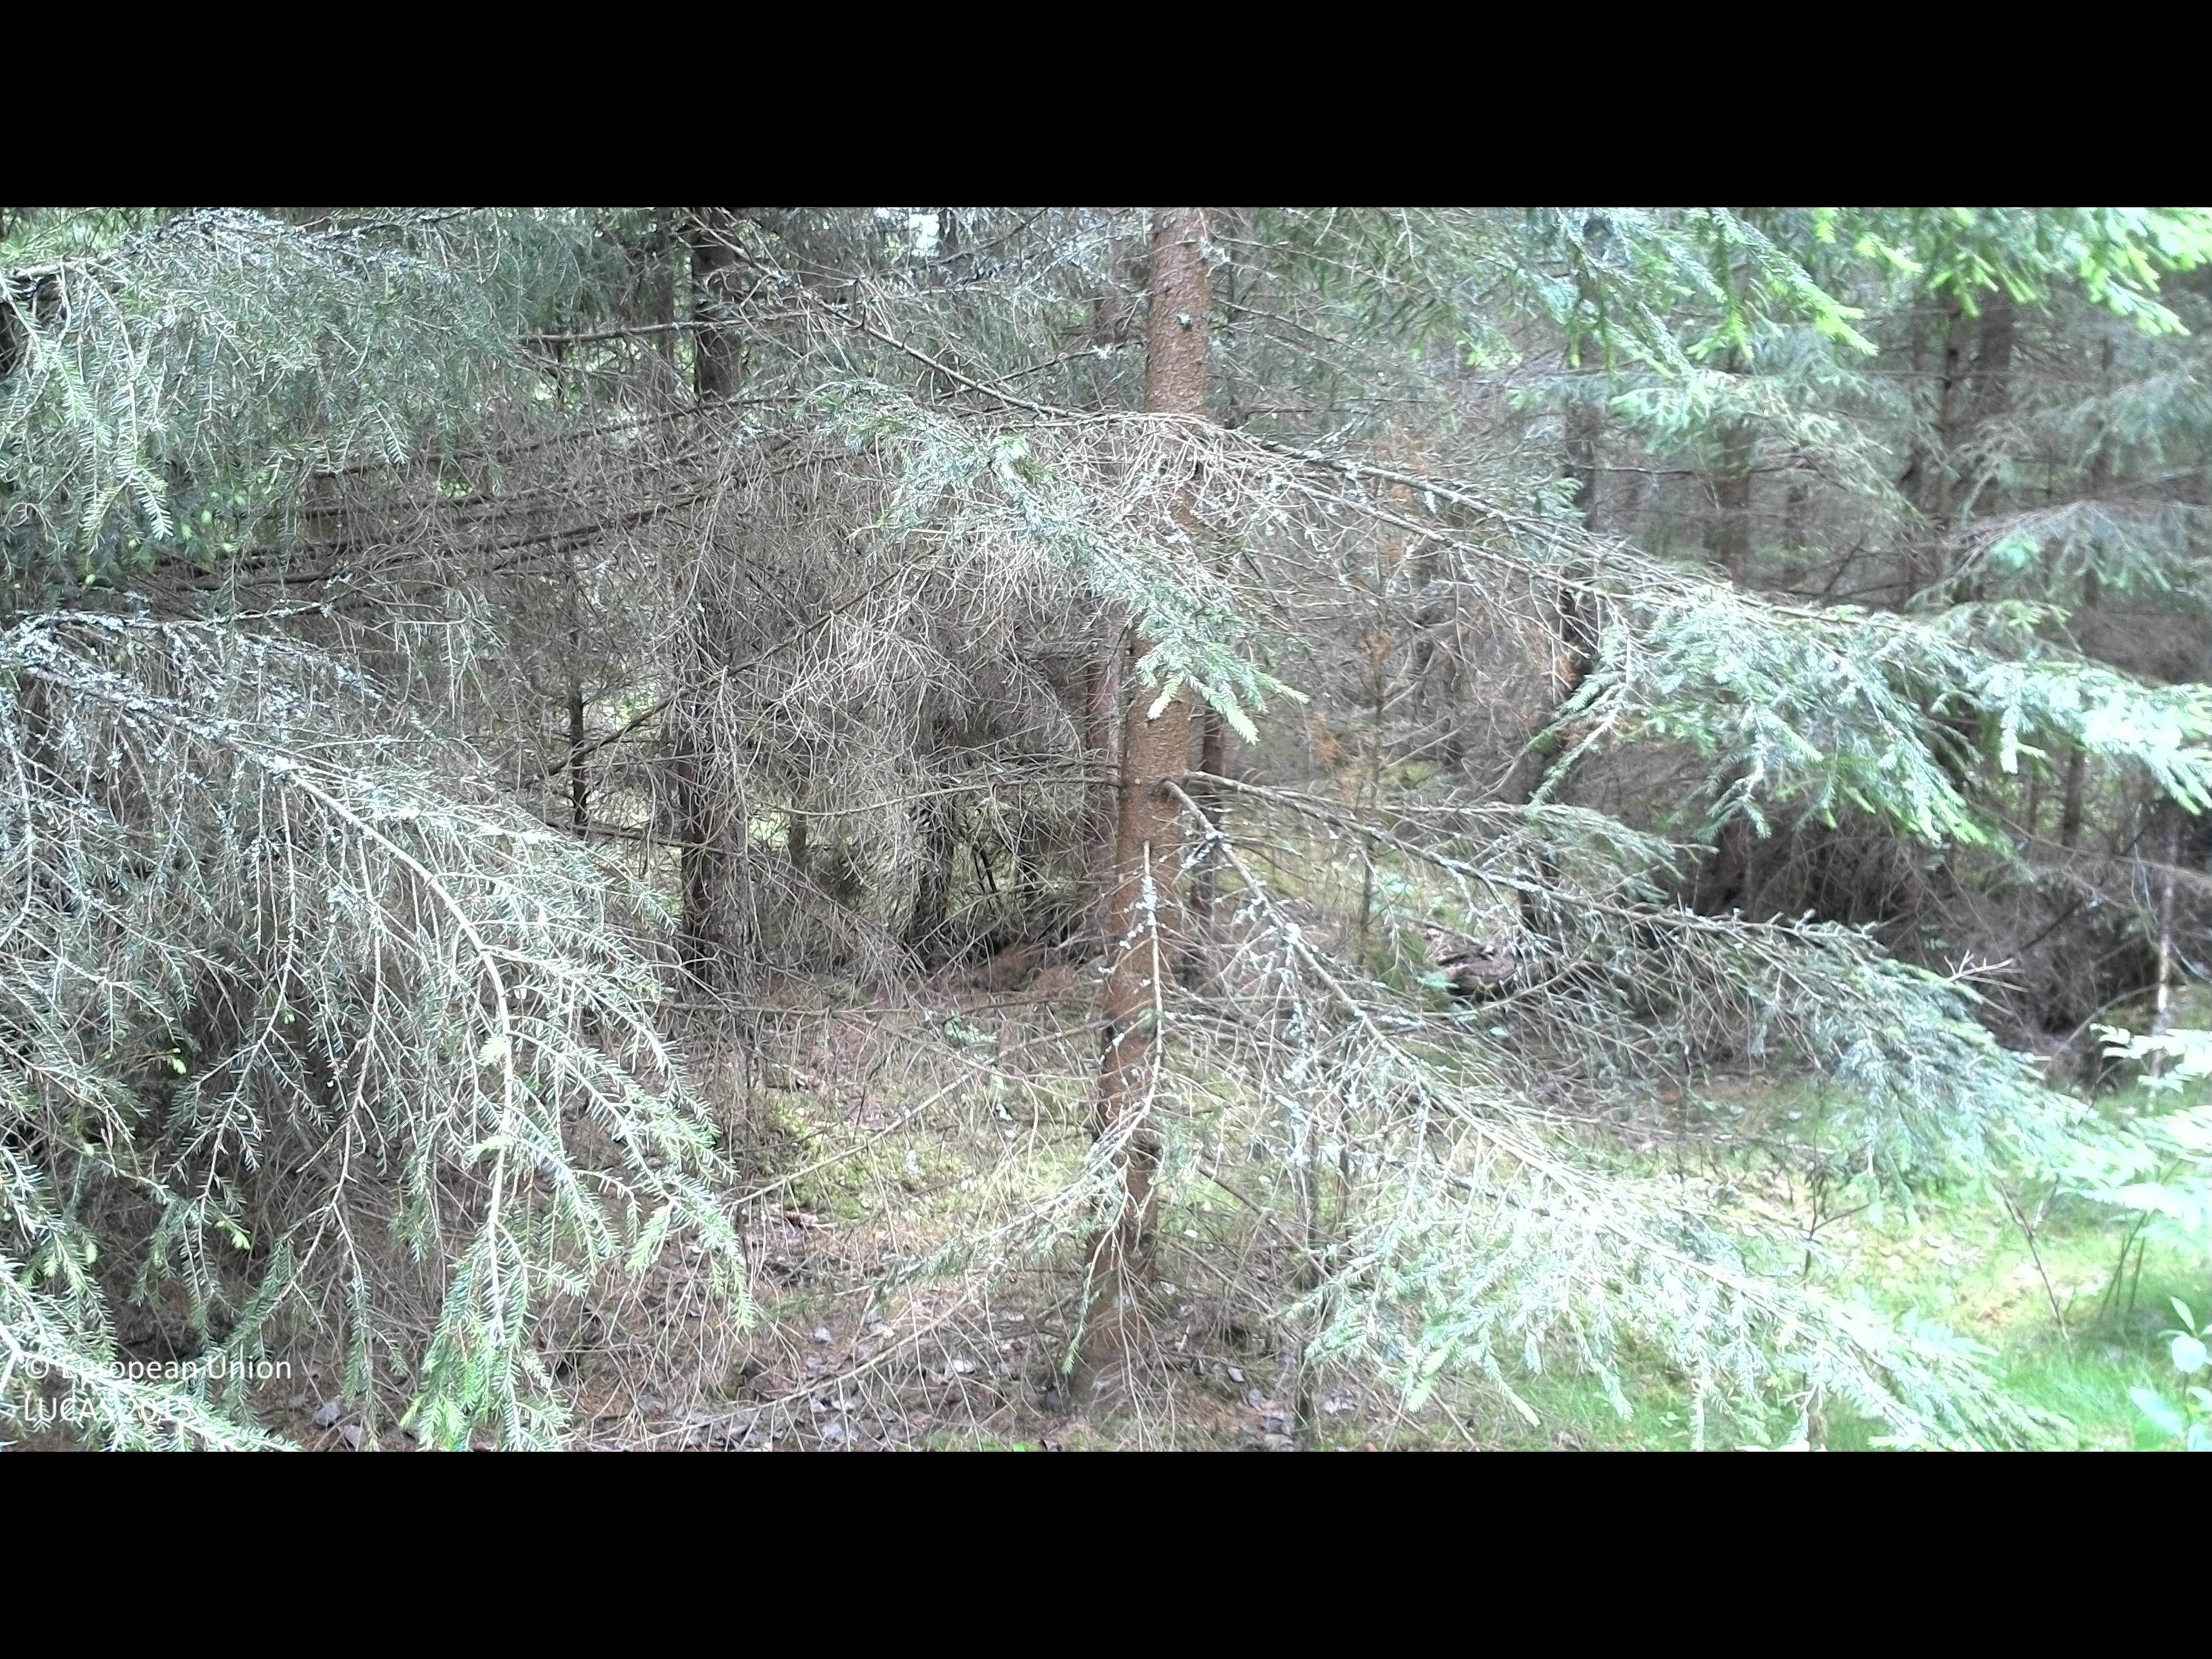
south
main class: Woodland
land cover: Spruce dominated coniferous woodland
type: boreal forest
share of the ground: > 75 %
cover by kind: coniferous forest trees 70 %, herbaceous plants 15 %, broadleaved forest trees 5 %, shrubs 5 %, lichens and mosses 5 %
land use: Forestry
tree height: > 5 m
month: July
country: SE
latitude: 56.4768
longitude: 14.7873
